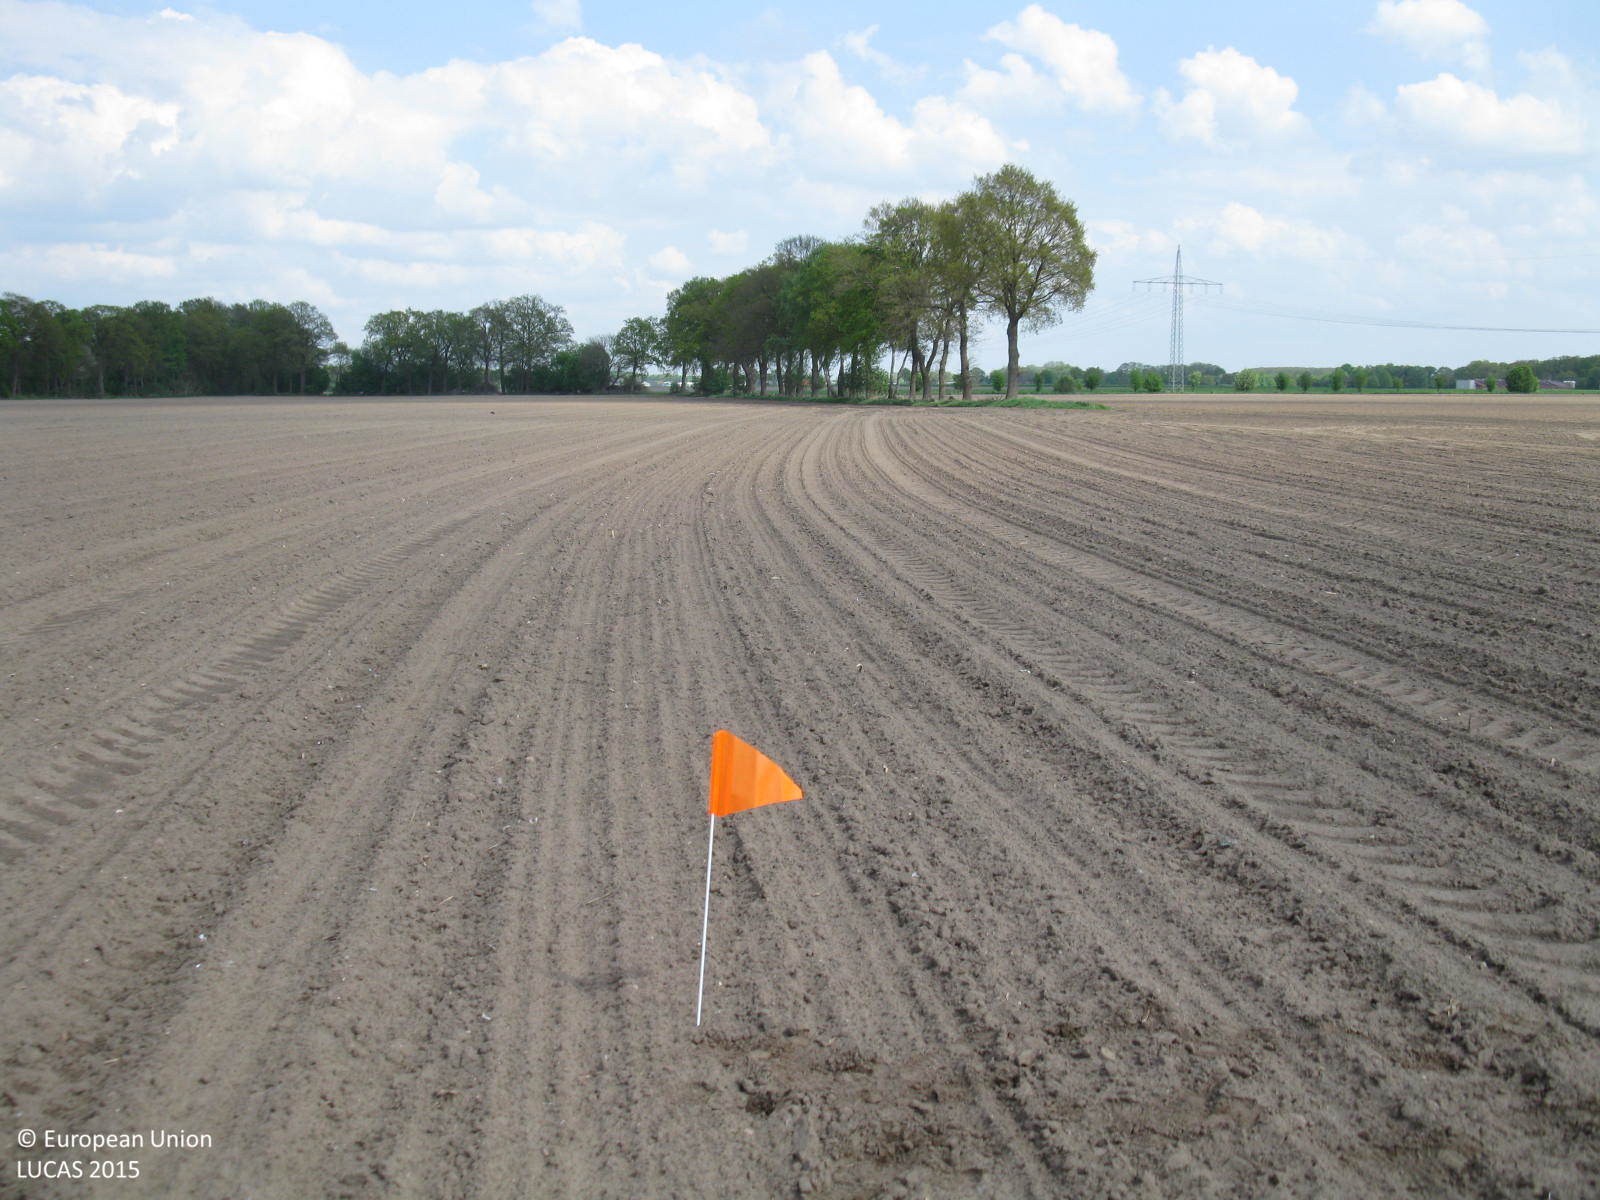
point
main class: Cropland
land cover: Maize
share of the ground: > 75 %
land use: Agriculture (excluding fallow land and kitchen gardens)
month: May
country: DE
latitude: 52.8276
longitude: 7.9673
